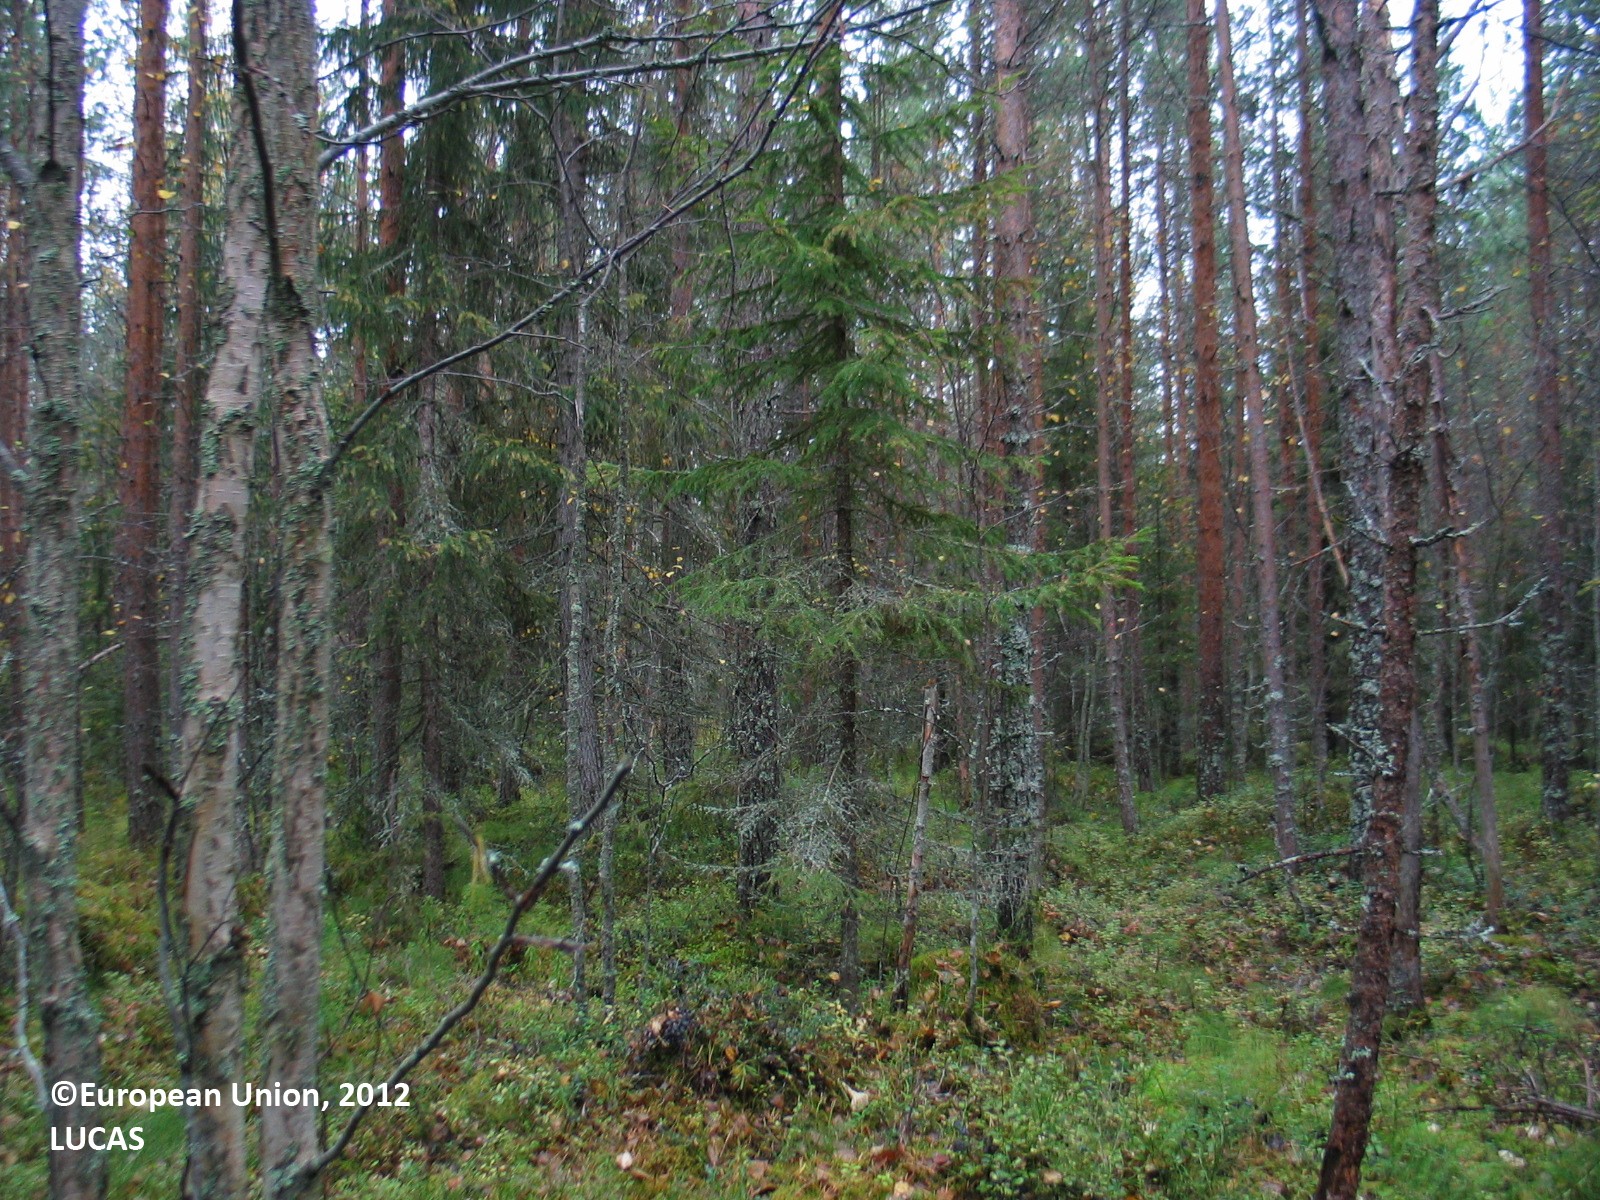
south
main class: Woodland
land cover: Pine dominated coniferous woodland
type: mire and swamp forests
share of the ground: 50 - 75 %
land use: Forestry
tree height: > 5 m
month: September
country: FI
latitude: 65.3824
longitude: 25.5490
